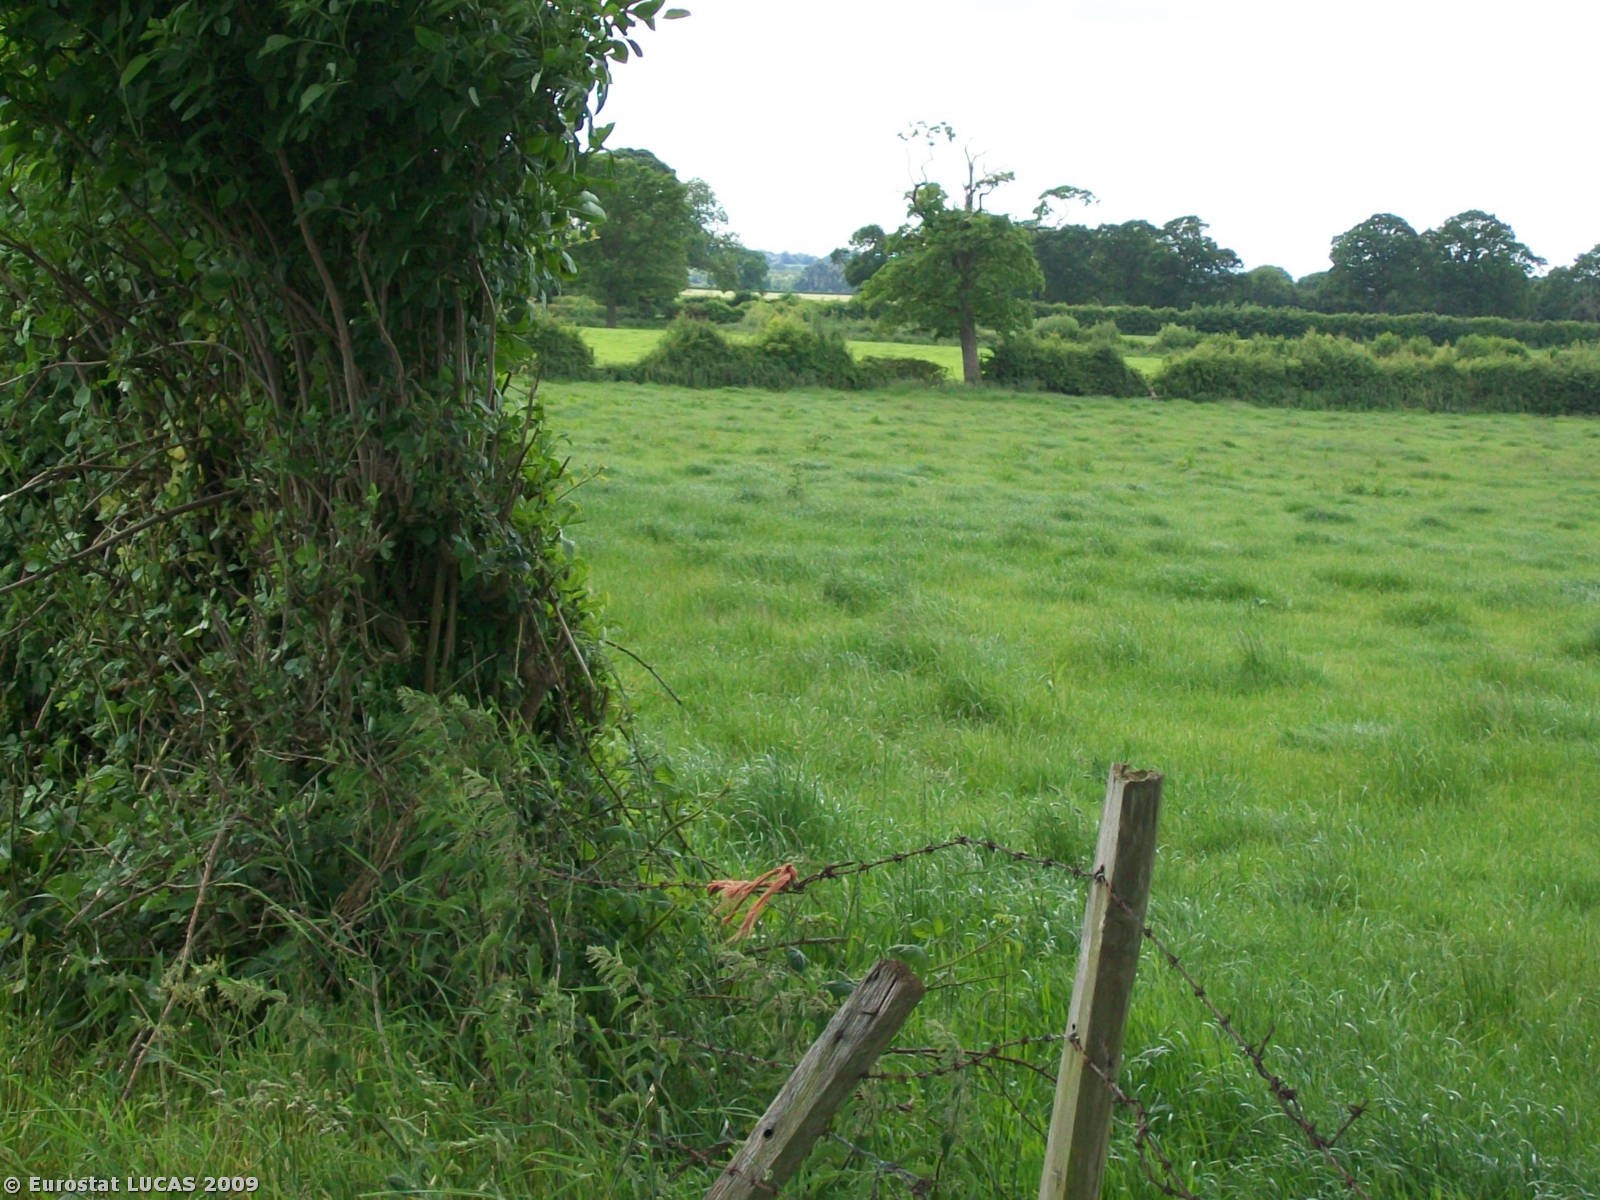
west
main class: Grassland
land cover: Grassland without tree/shrub cover
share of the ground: > 75 %
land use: Agriculture (excluding fallow land and kitchen gardens)
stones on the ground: < 10 %
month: June
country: GB
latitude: 52.9395
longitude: -2.6116
